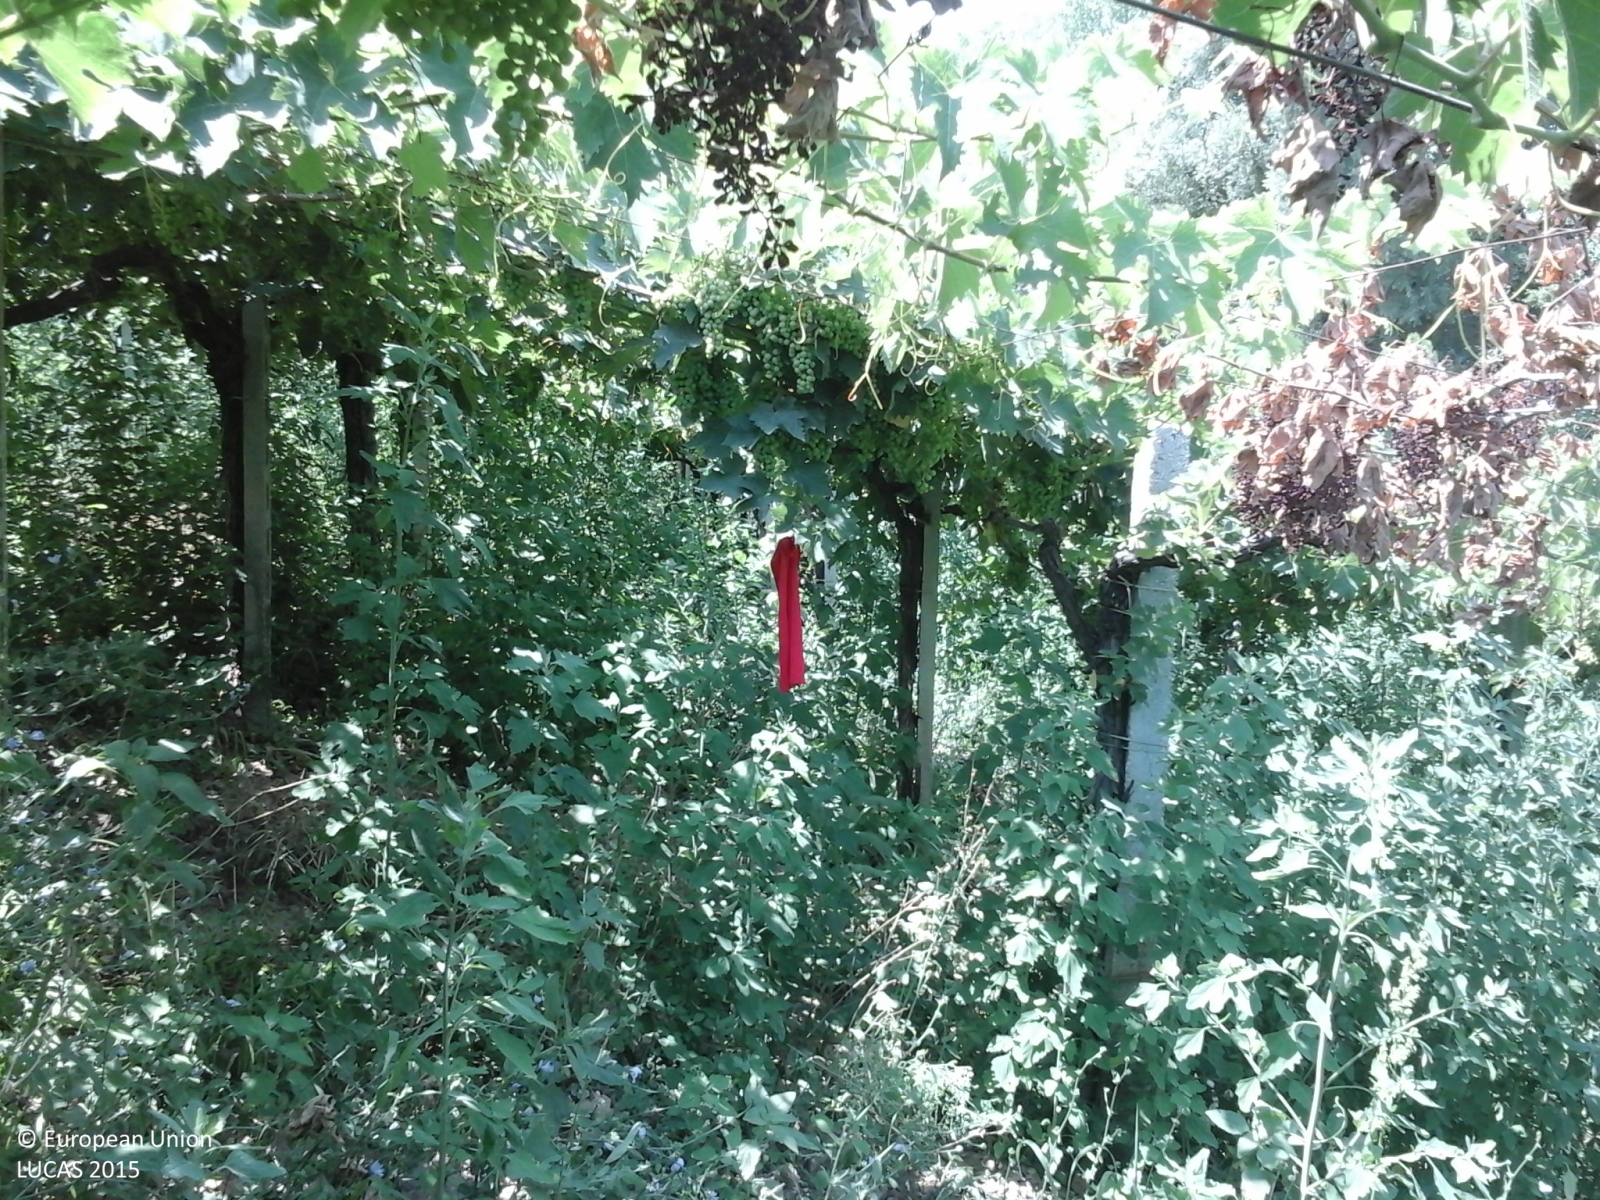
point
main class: Cropland
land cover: Vineyards
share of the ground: 25 - 50 %
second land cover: Spontaneously vegetated surfaces
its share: 25 - 50 %
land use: Agriculture (excluding fallow land and kitchen gardens)
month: July
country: IT
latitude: 42.3118
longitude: 14.2455
